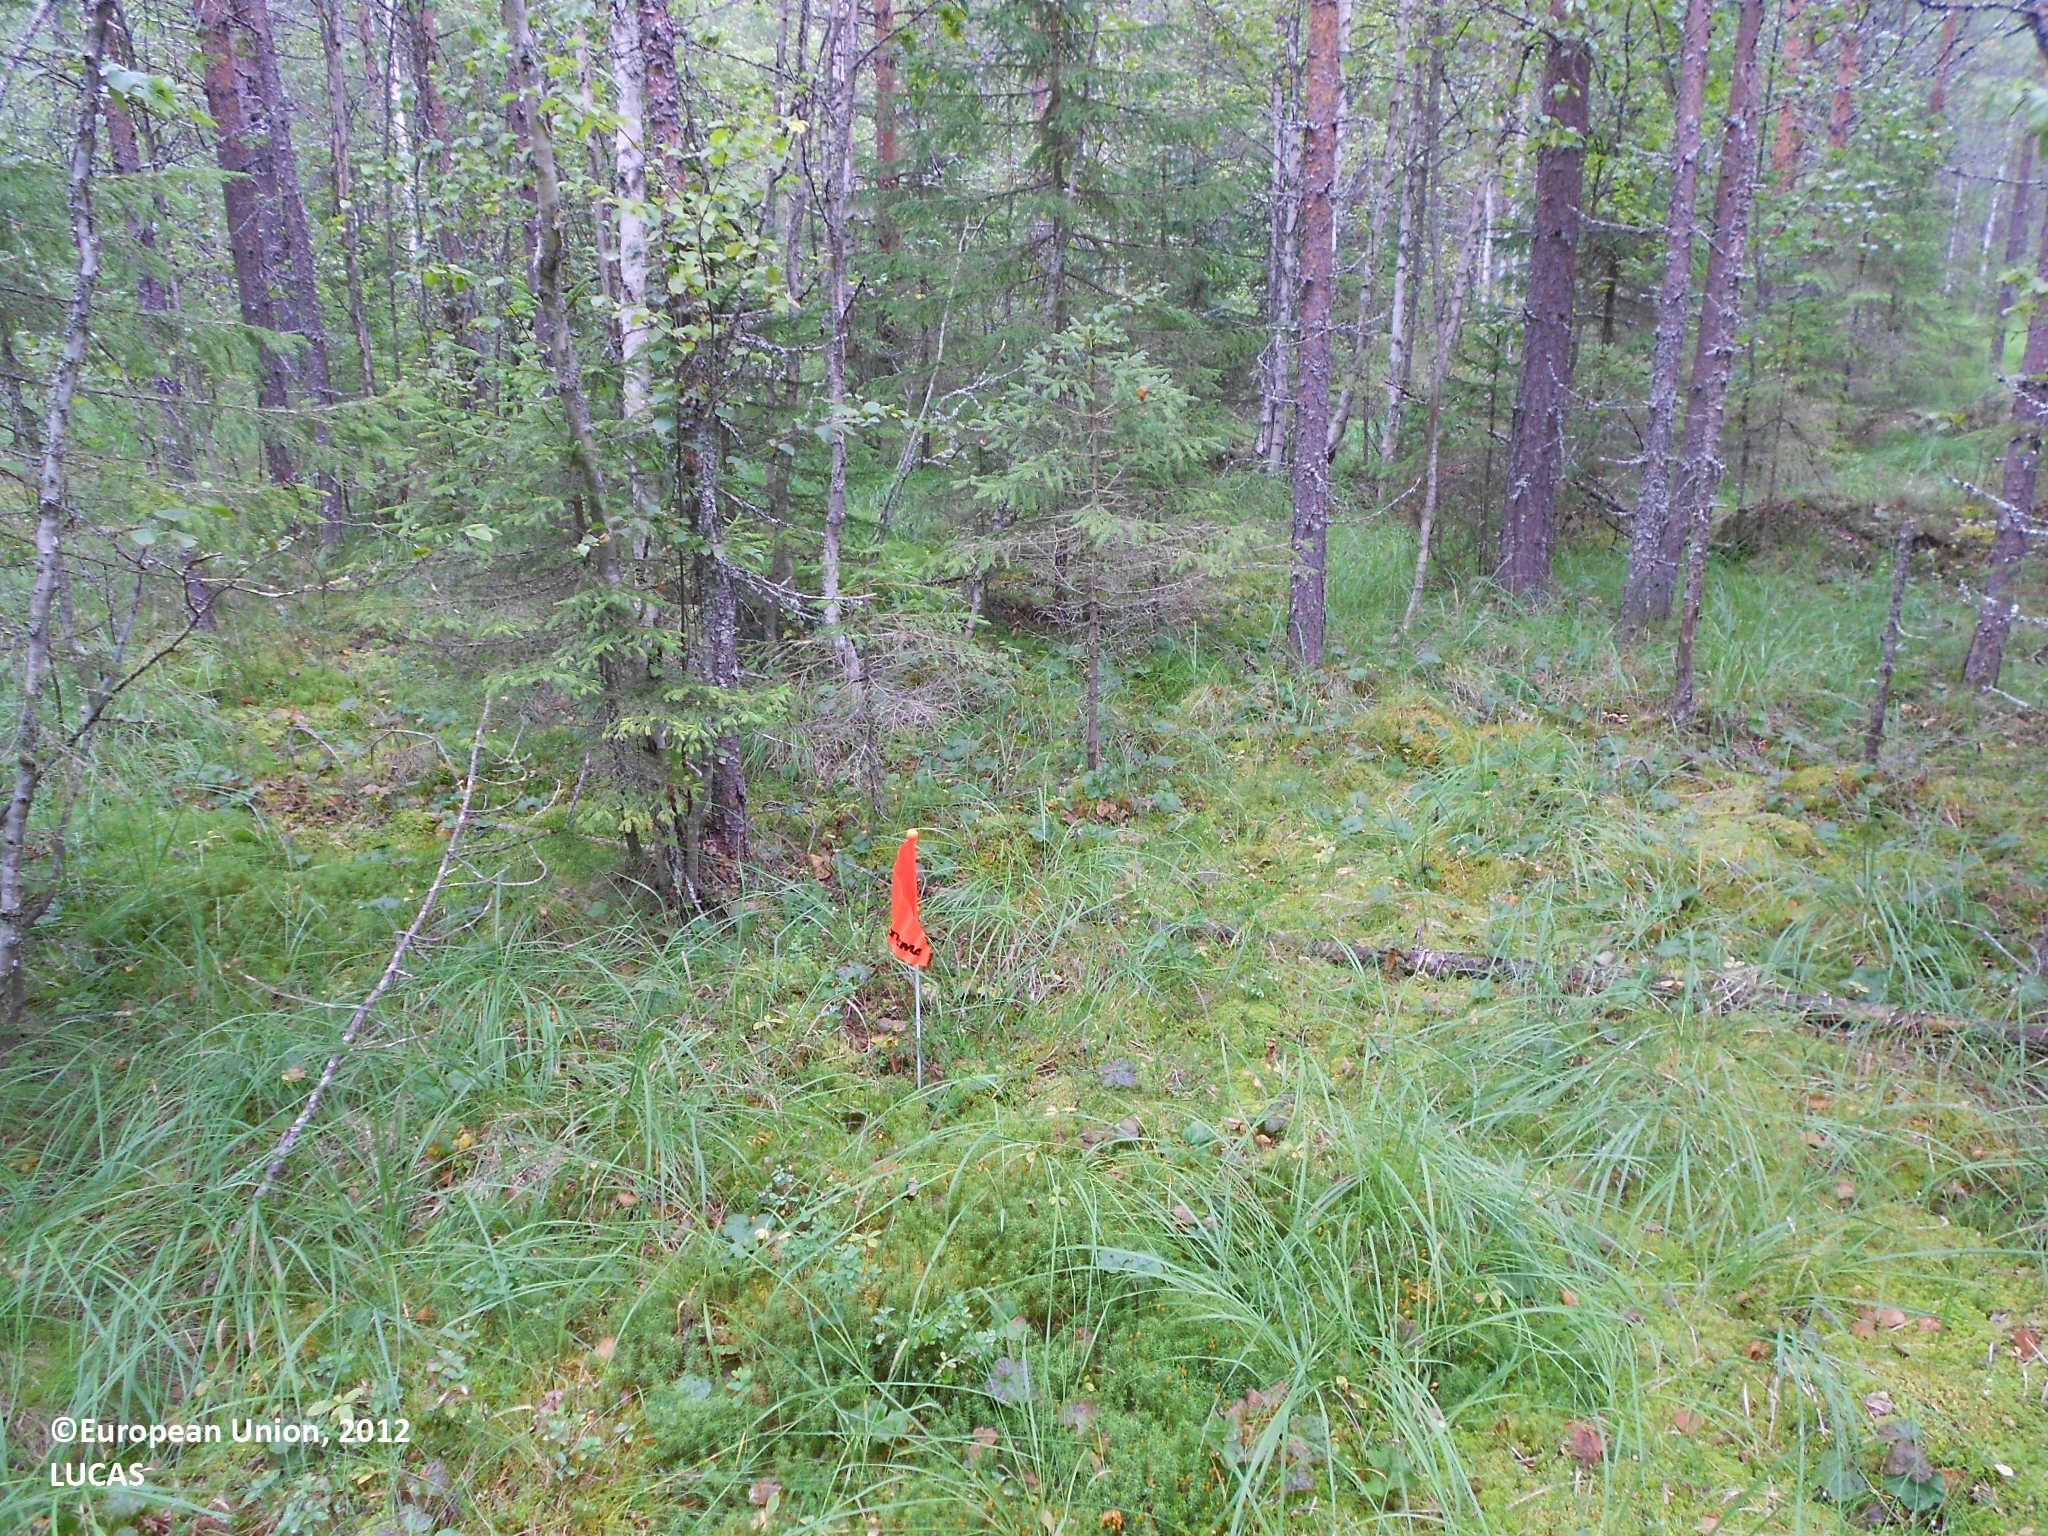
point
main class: Woodland
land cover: Pine dominated coniferous woodland
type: boreal forest
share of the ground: 50 - 75 %
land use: Forestry
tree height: > 5 m
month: August
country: FI
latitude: 63.4263
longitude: 28.9402
